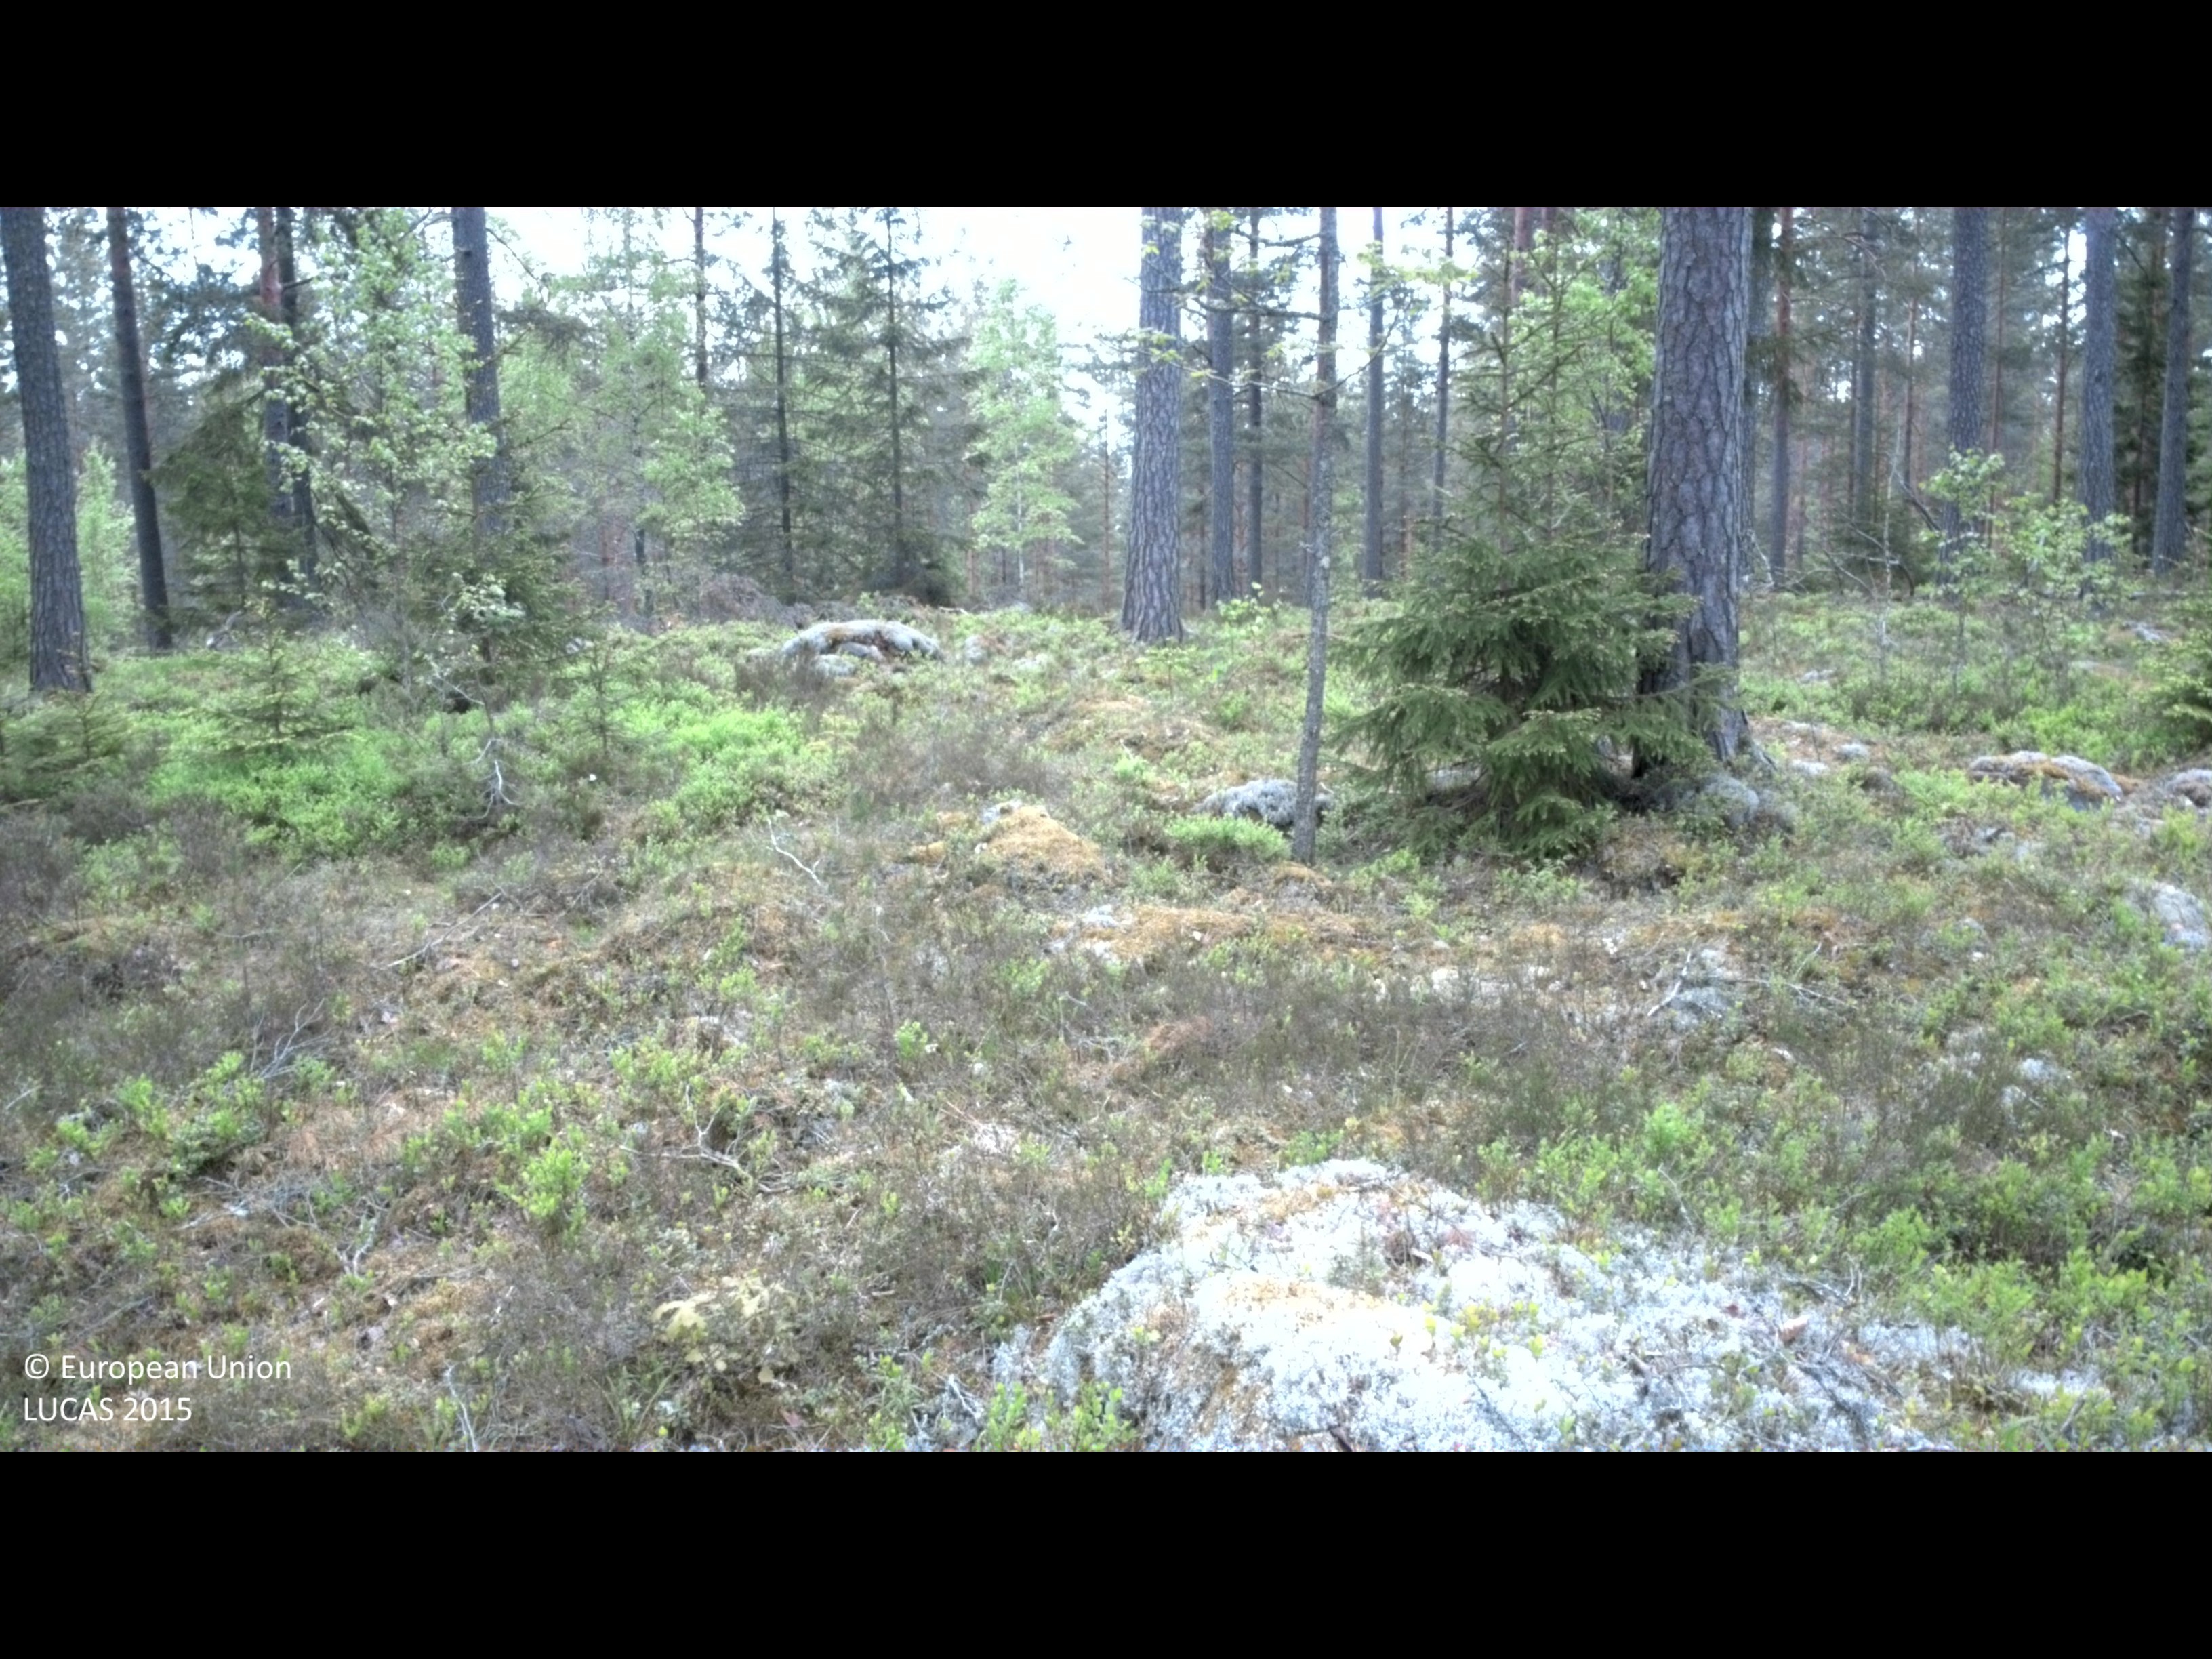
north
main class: Woodland
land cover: Pine dominated coniferous woodland
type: boreal forest
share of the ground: 50 - 75 %
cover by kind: coniferous forest trees 60 %, shrubs 30 %, broadleaved forest trees 5 %, lichens and mosses 5 %
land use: Forestry
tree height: > 5 m
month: May
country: SE
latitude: 57.4295
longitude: 16.1441
